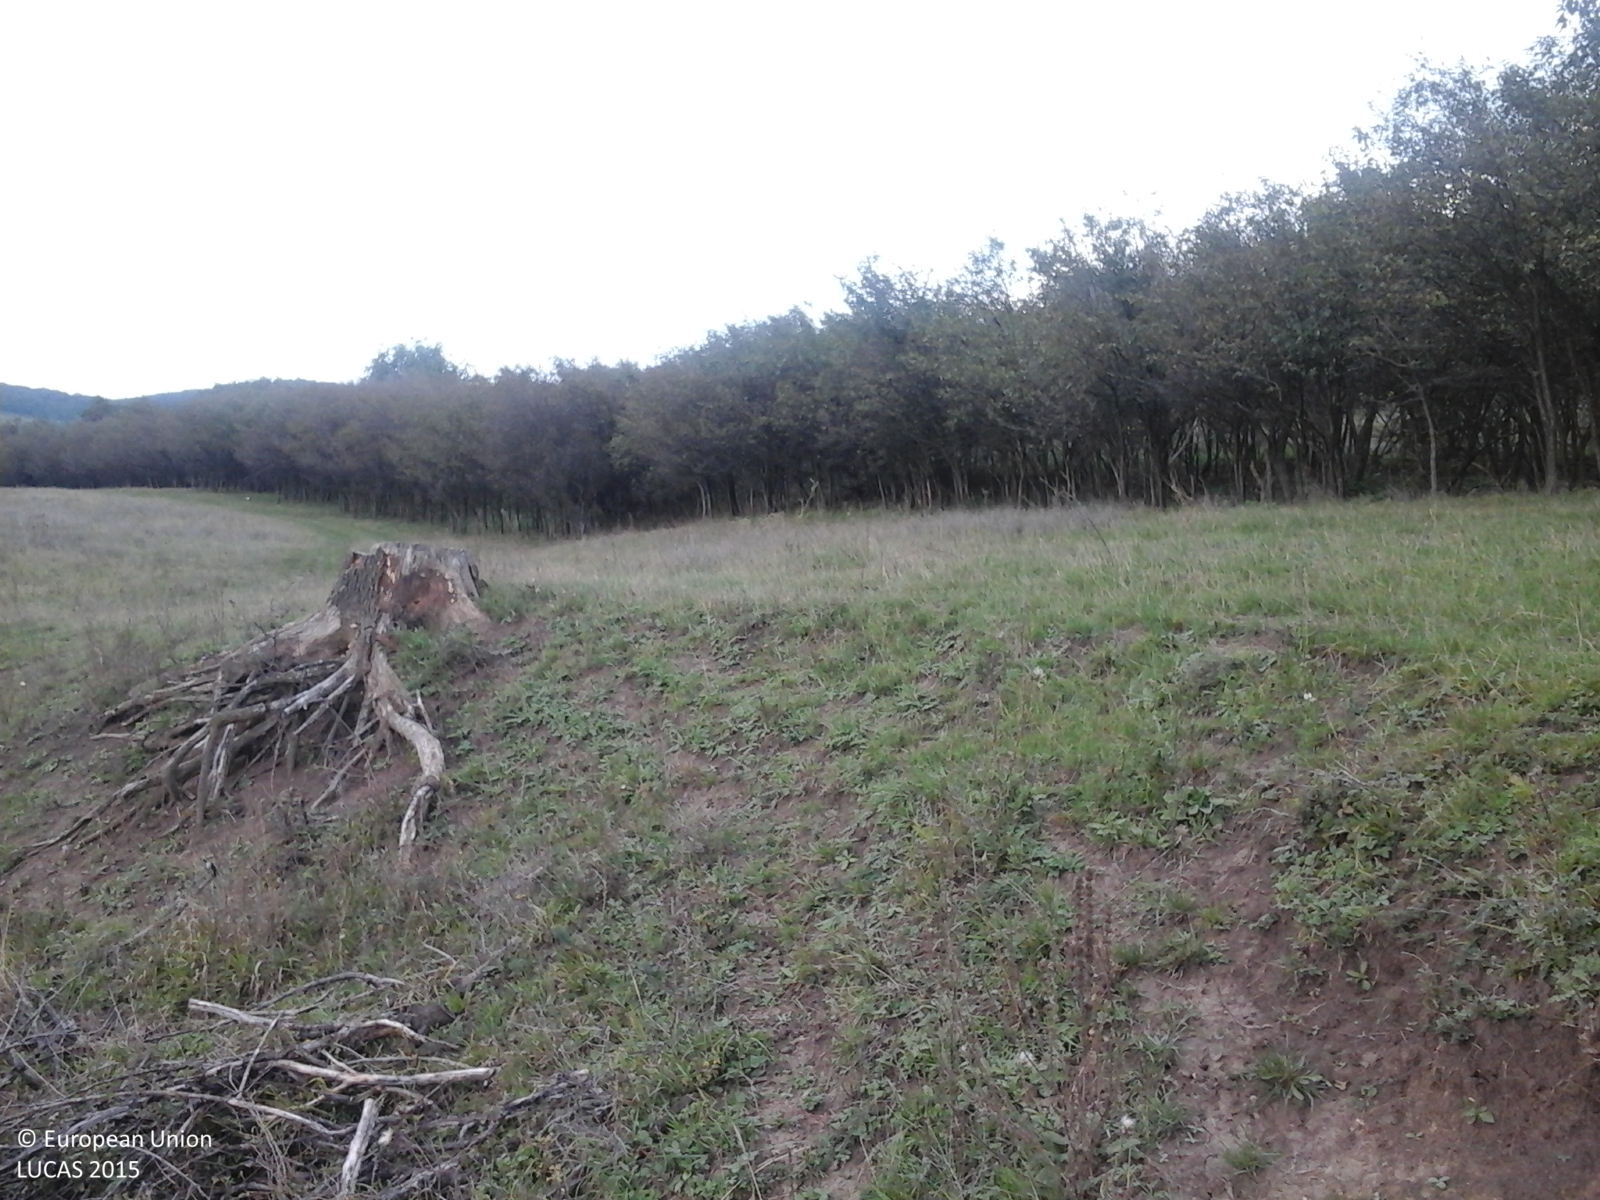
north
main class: Grassland
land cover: Grassland without tree/shrub cover
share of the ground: > 75 %
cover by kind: herbaceous plants 100 %
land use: Agriculture (excluding fallow land and kitchen gardens)
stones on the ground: < 10 %
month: October
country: RO
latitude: 46.2527
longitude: 24.2317
